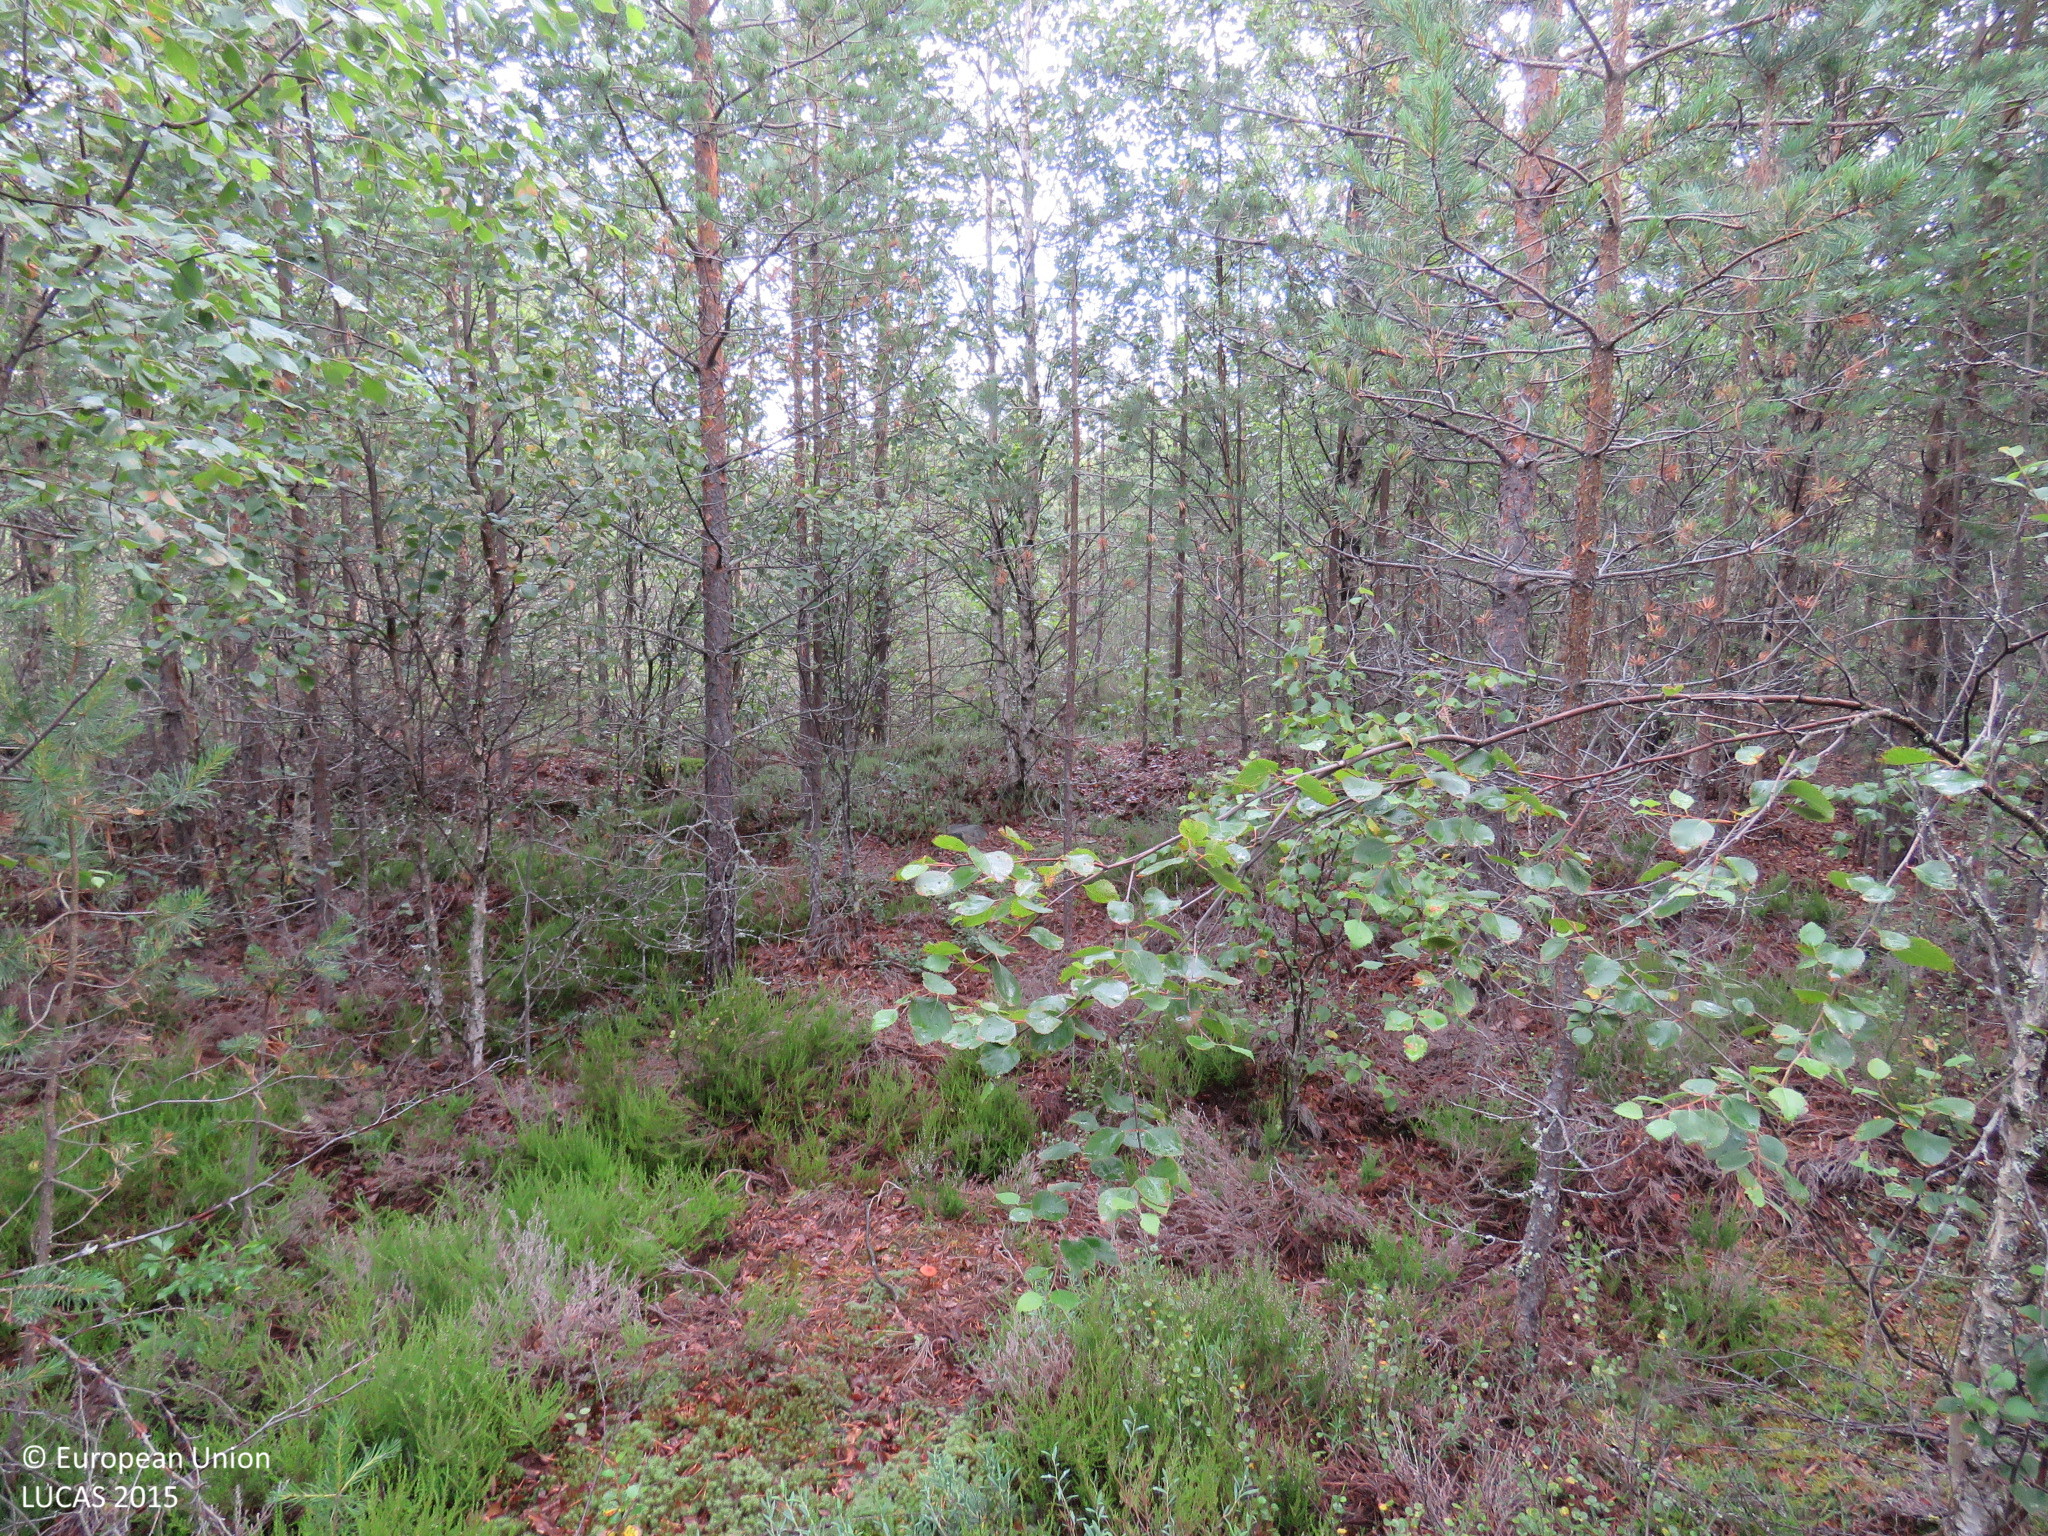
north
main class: Woodland
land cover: Pine dominated mixed woodland
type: mire and swamp forests
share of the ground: > 75 %
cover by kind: broadleaved forest trees 50 %, coniferous forest trees 40 %, shrubs 10 %
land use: Forestry
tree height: > 5 m
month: July
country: FI
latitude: 64.9162
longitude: 25.5827
